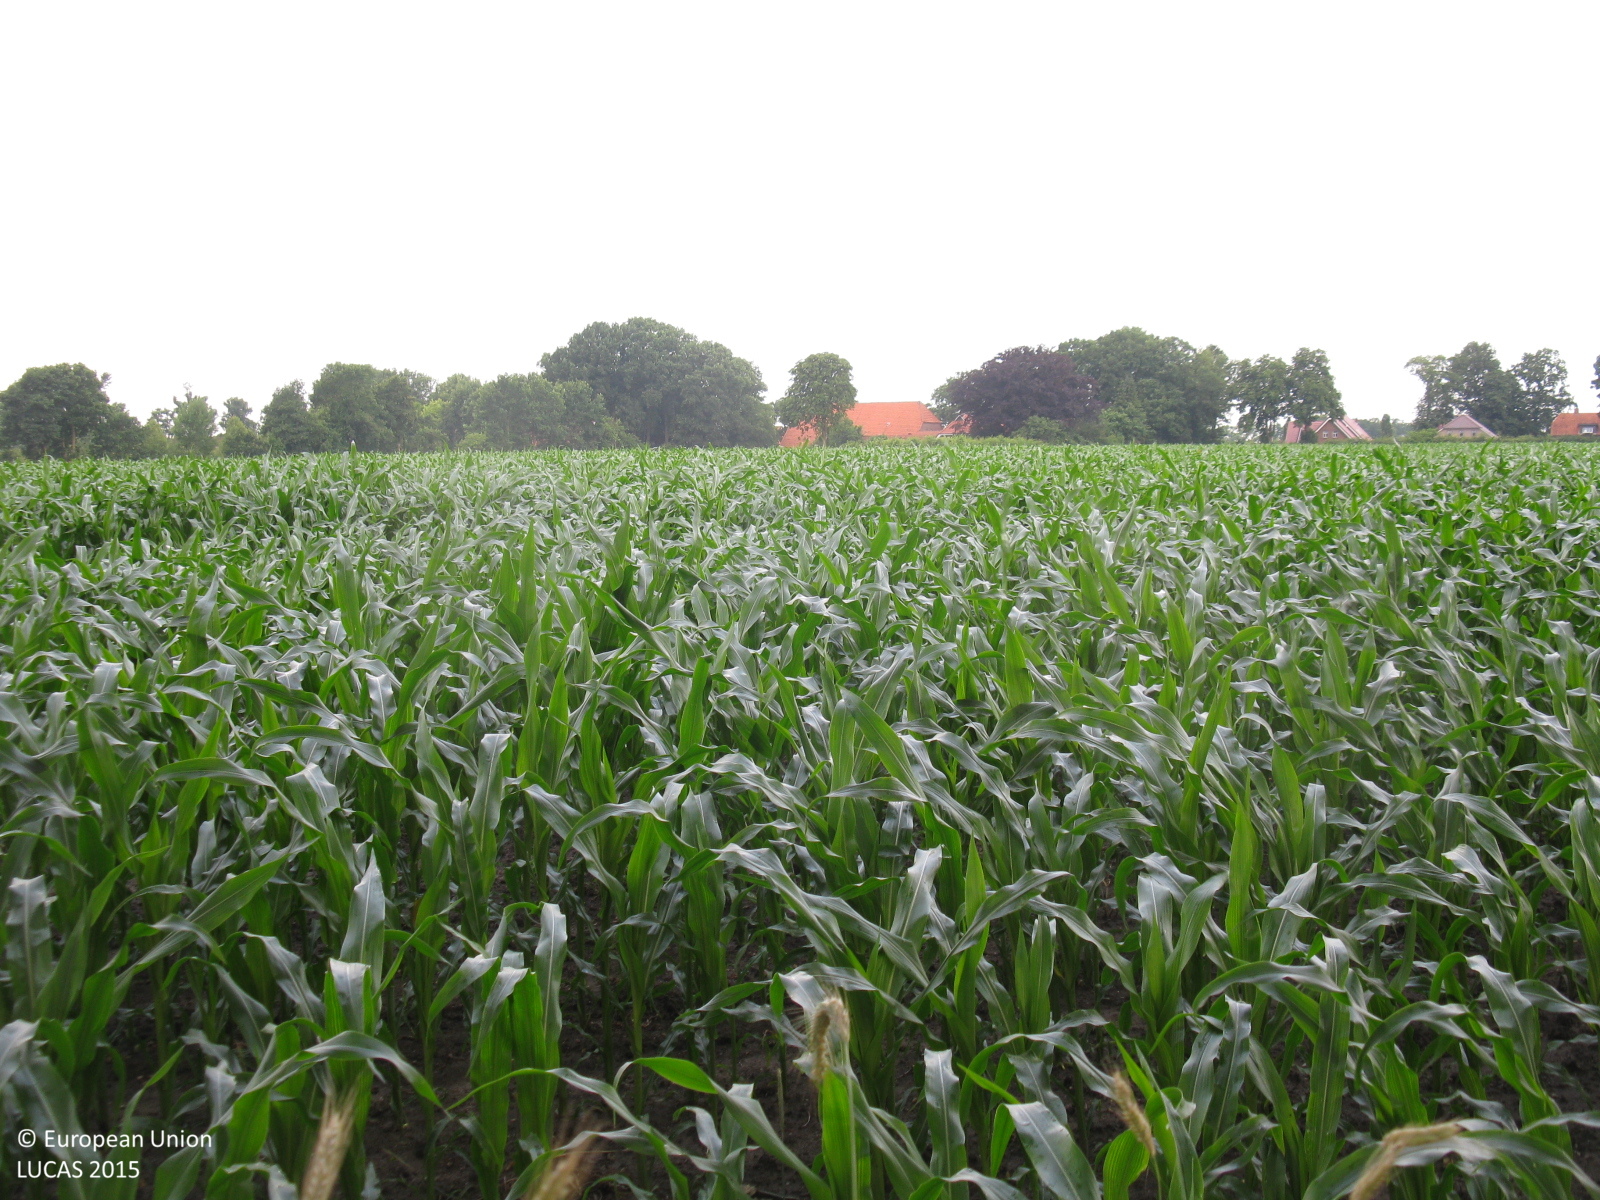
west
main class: Cropland
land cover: Maize
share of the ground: > 75 %
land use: Agriculture (excluding fallow land and kitchen gardens)
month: July
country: DE
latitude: 53.2412
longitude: 7.9778
